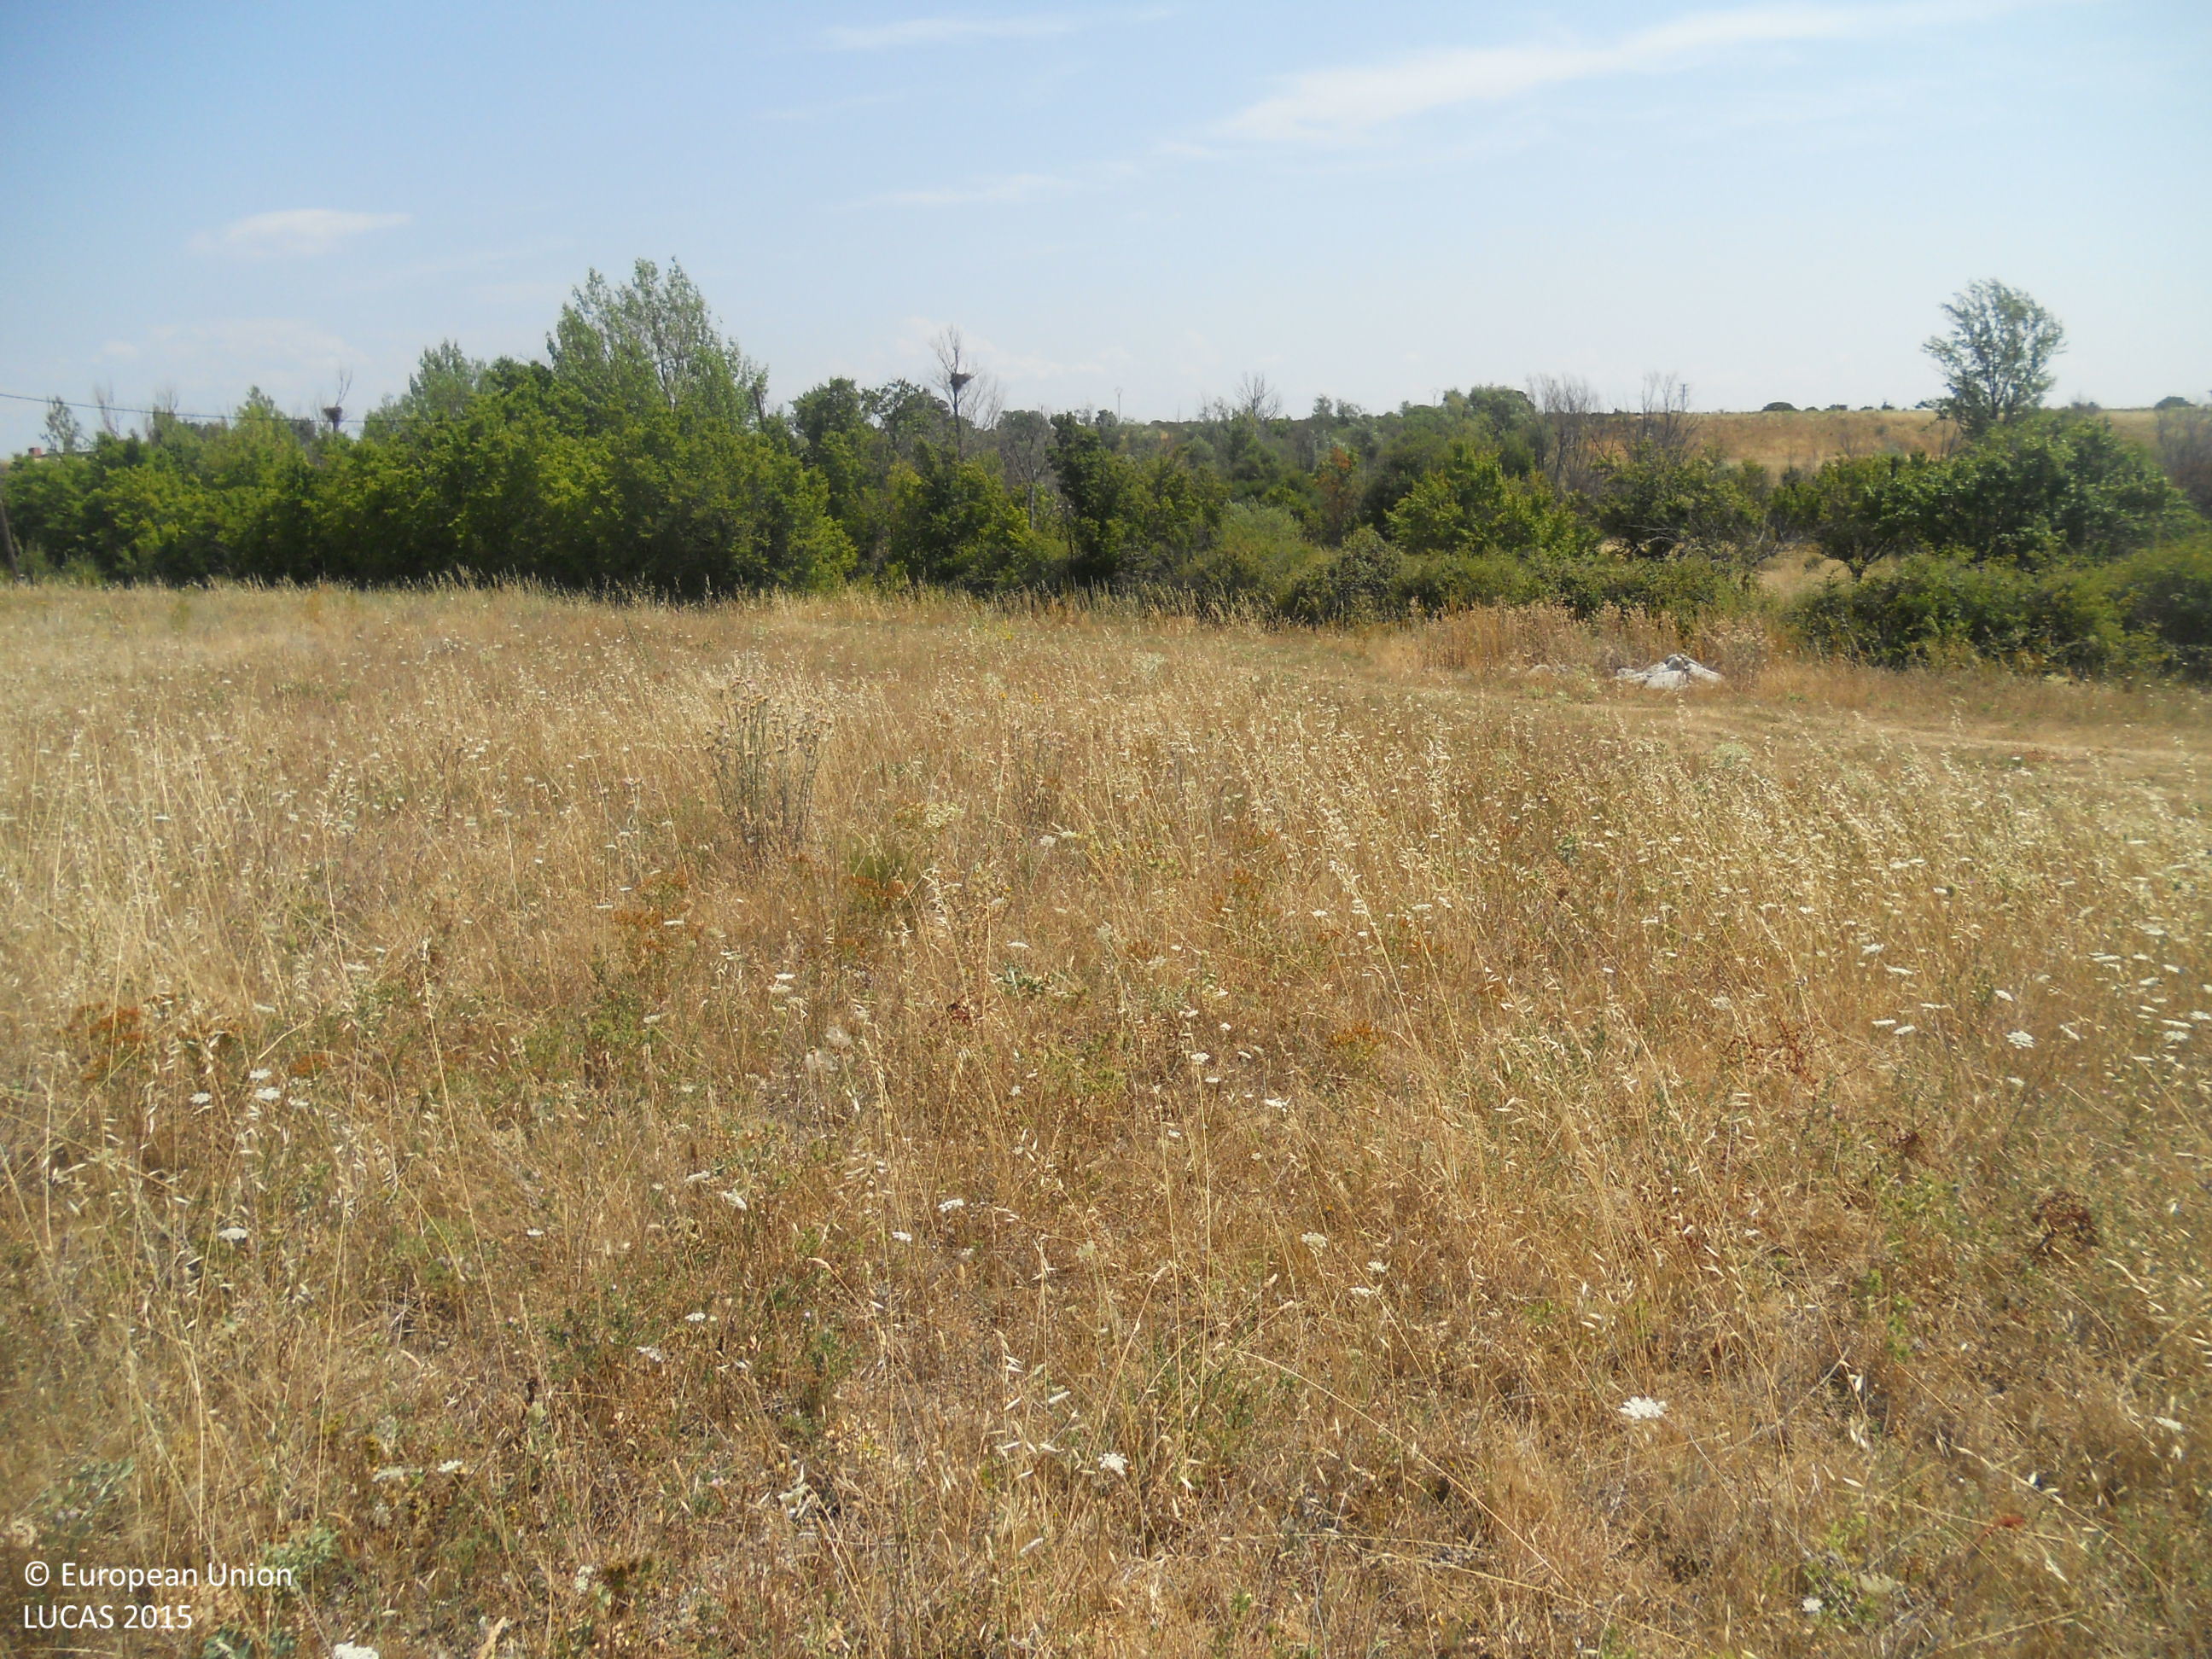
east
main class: Grassland
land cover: Grassland without tree/shrub cover
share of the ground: > 75 %
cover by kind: herbaceous plants 100 %
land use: Semi-natural and natural areas not in use
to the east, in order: Grassland without tree/shrub cover; Tracks; Grassland without tree/shrub cover; Shruby margins; Grassland without tree/shrub cover; Shruby margins; Grassland without tree/shrub cover; Tracks; Broadleaved woodland; Rivers and streams; Broadleaved woodland; Grassland without tree/shrub cover
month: July
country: ES
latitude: 42.5738
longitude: -5.6064
